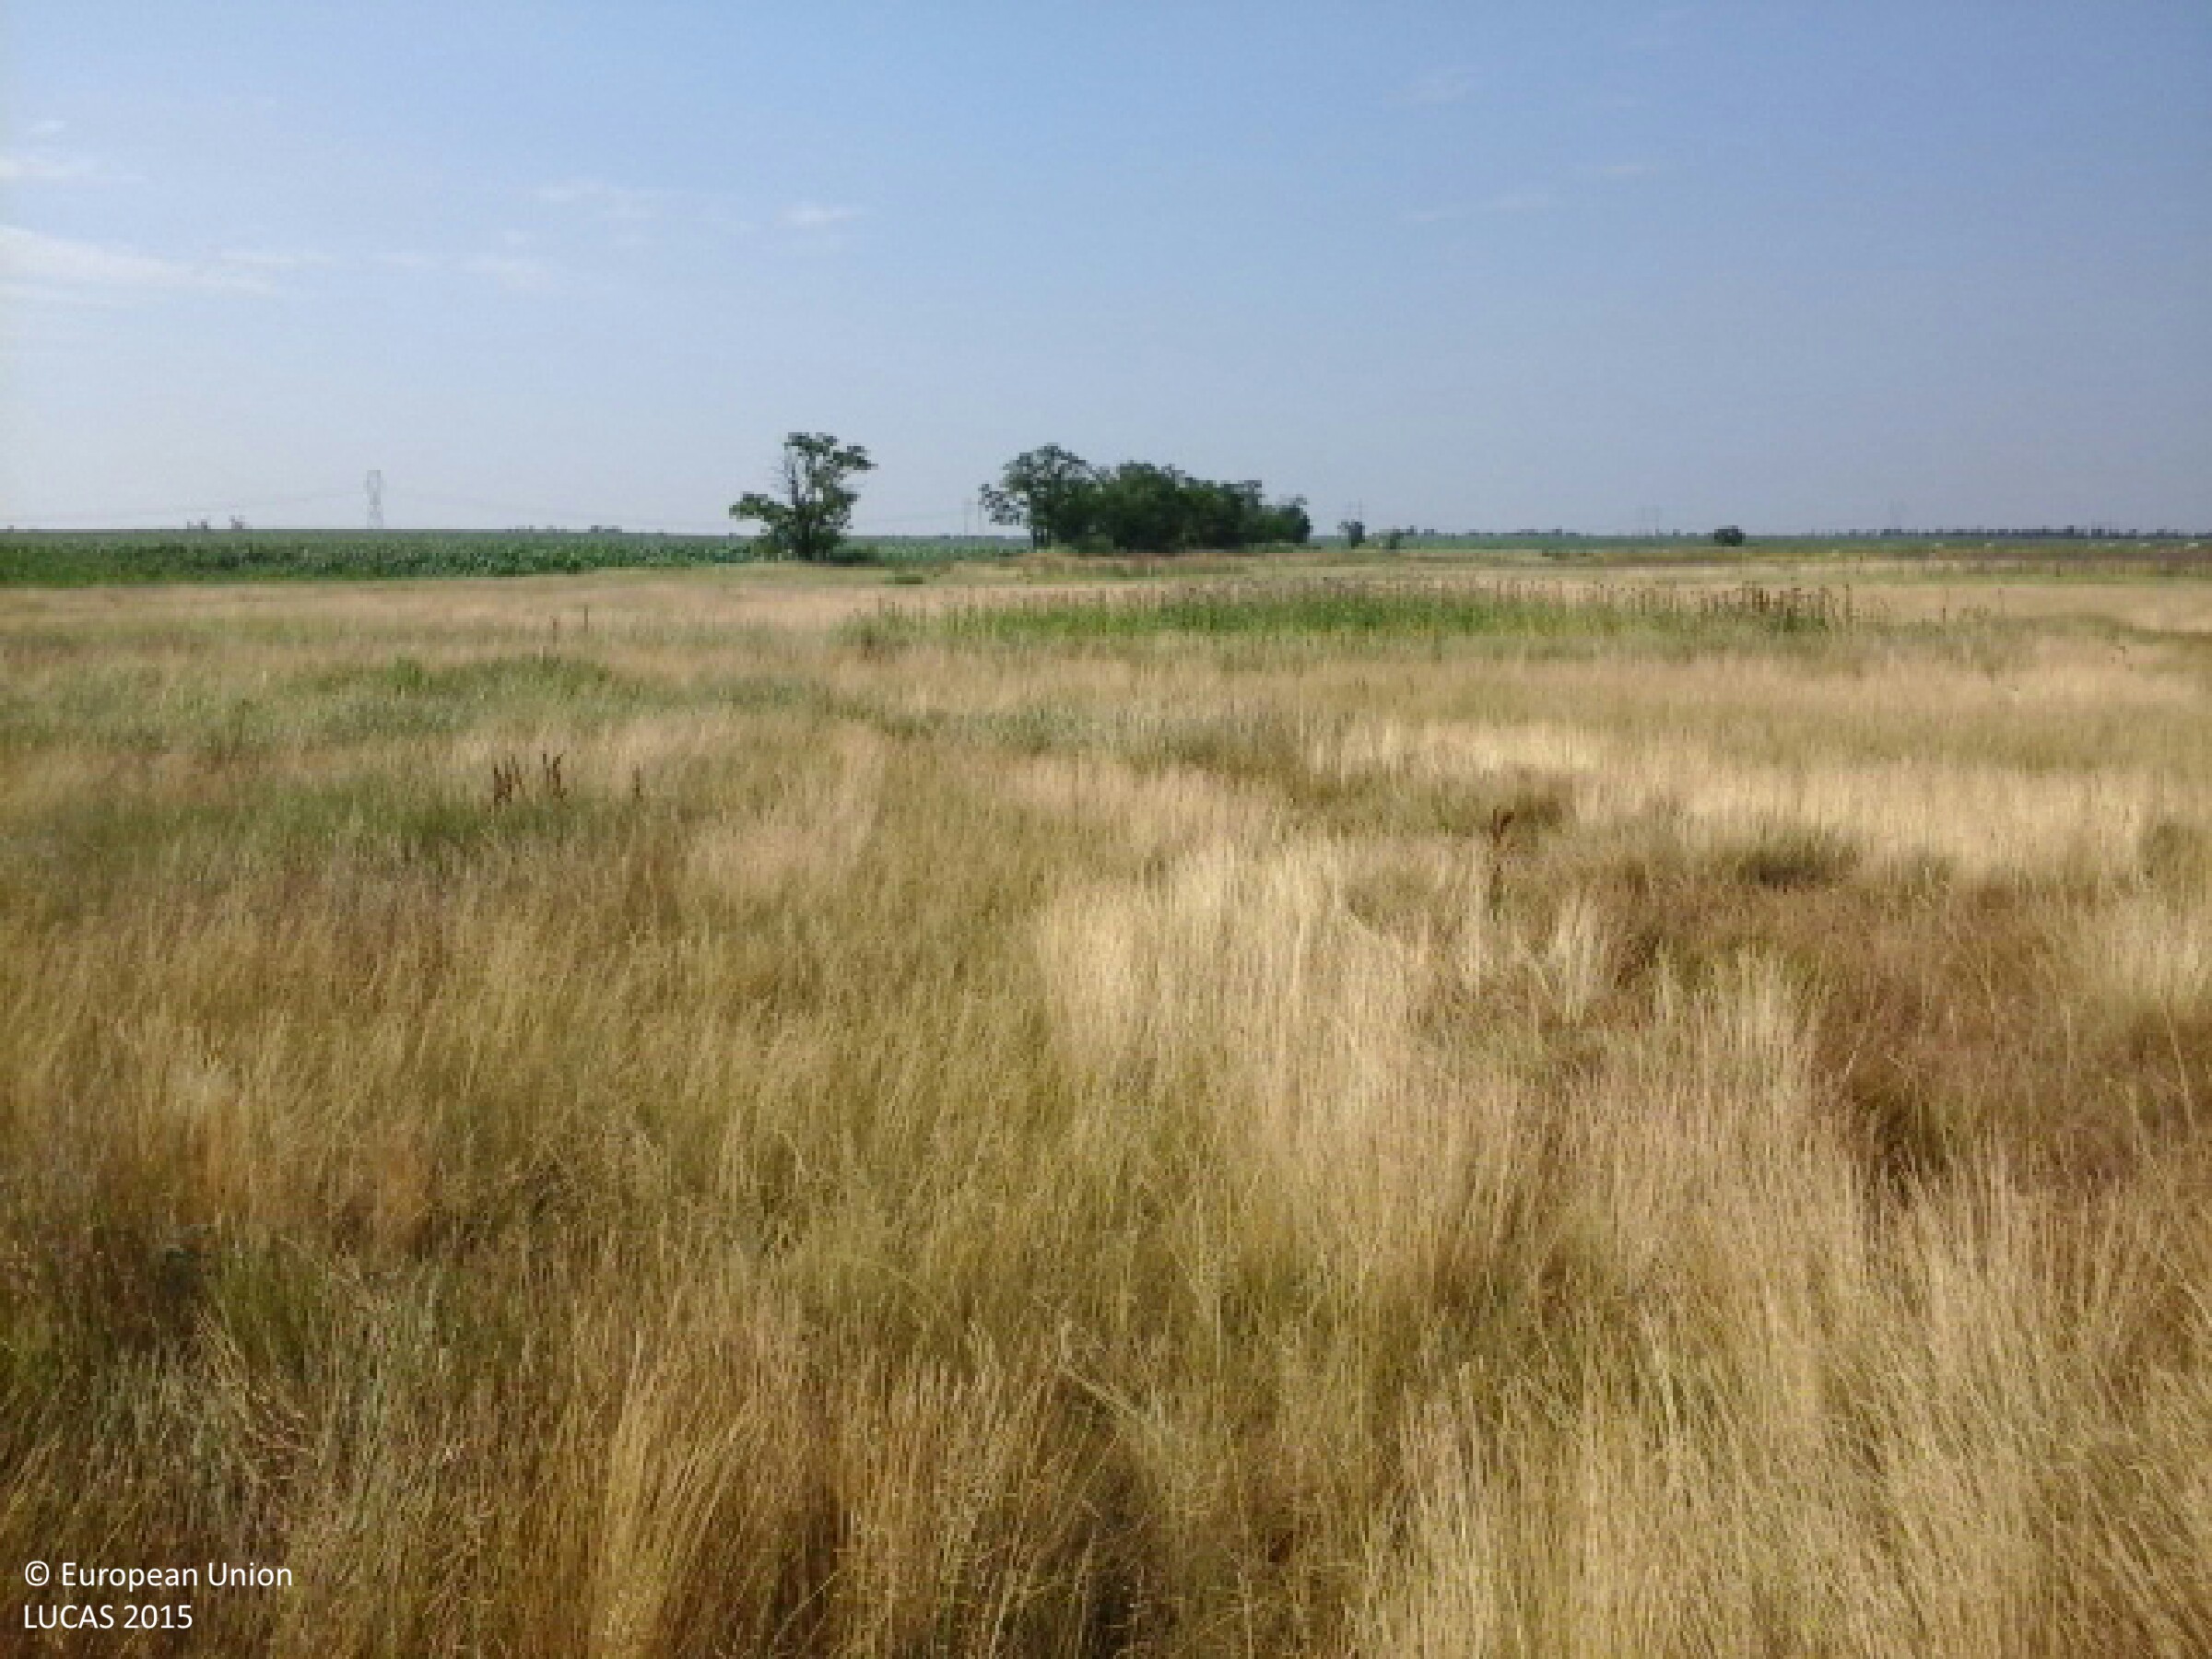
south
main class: Grassland
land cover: Grassland without tree/shrub cover
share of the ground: > 75 %
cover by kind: herbaceous plants 100 %
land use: Semi-natural and natural areas not in use
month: June
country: HU
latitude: 48.0007
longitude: 21.5045
